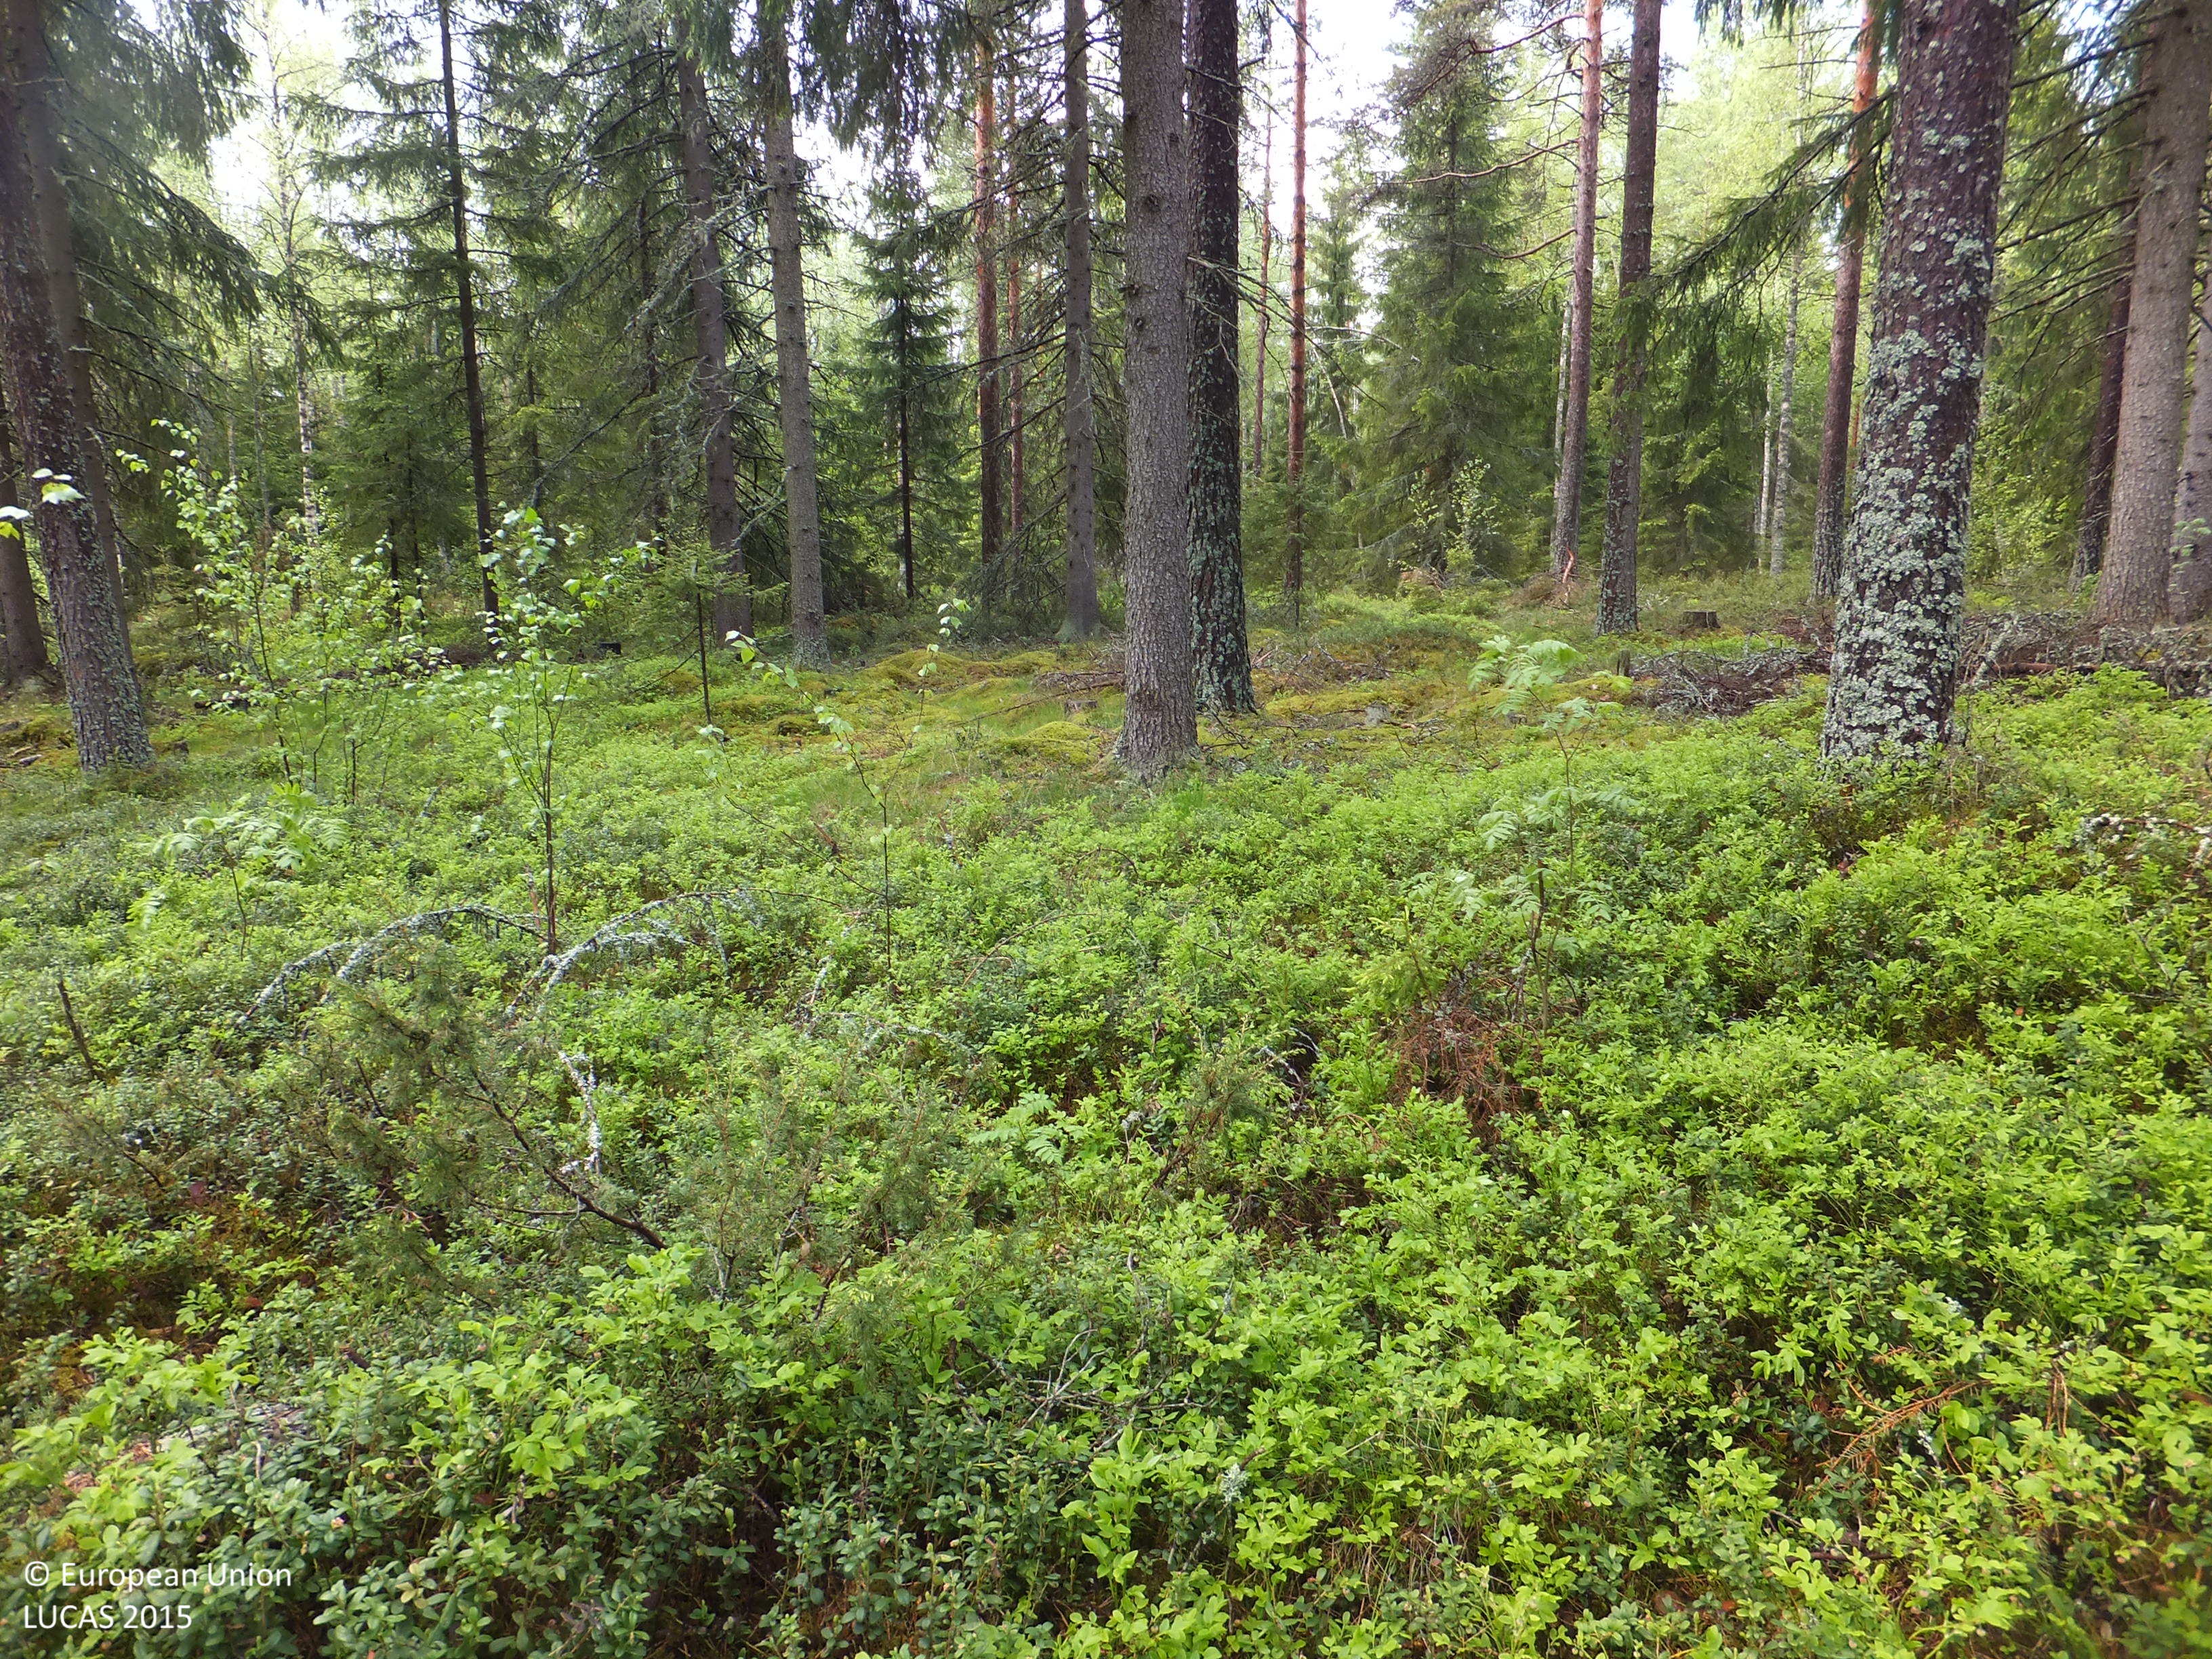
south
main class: Woodland
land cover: Pine dominated coniferous woodland
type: boreal forest
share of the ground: > 75 %
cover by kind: coniferous forest trees 75 %, shrubs 15 %, lichens and mosses 10 %
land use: Forestry
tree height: > 5 m
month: June
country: FI
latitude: 63.5562
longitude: 22.9138
